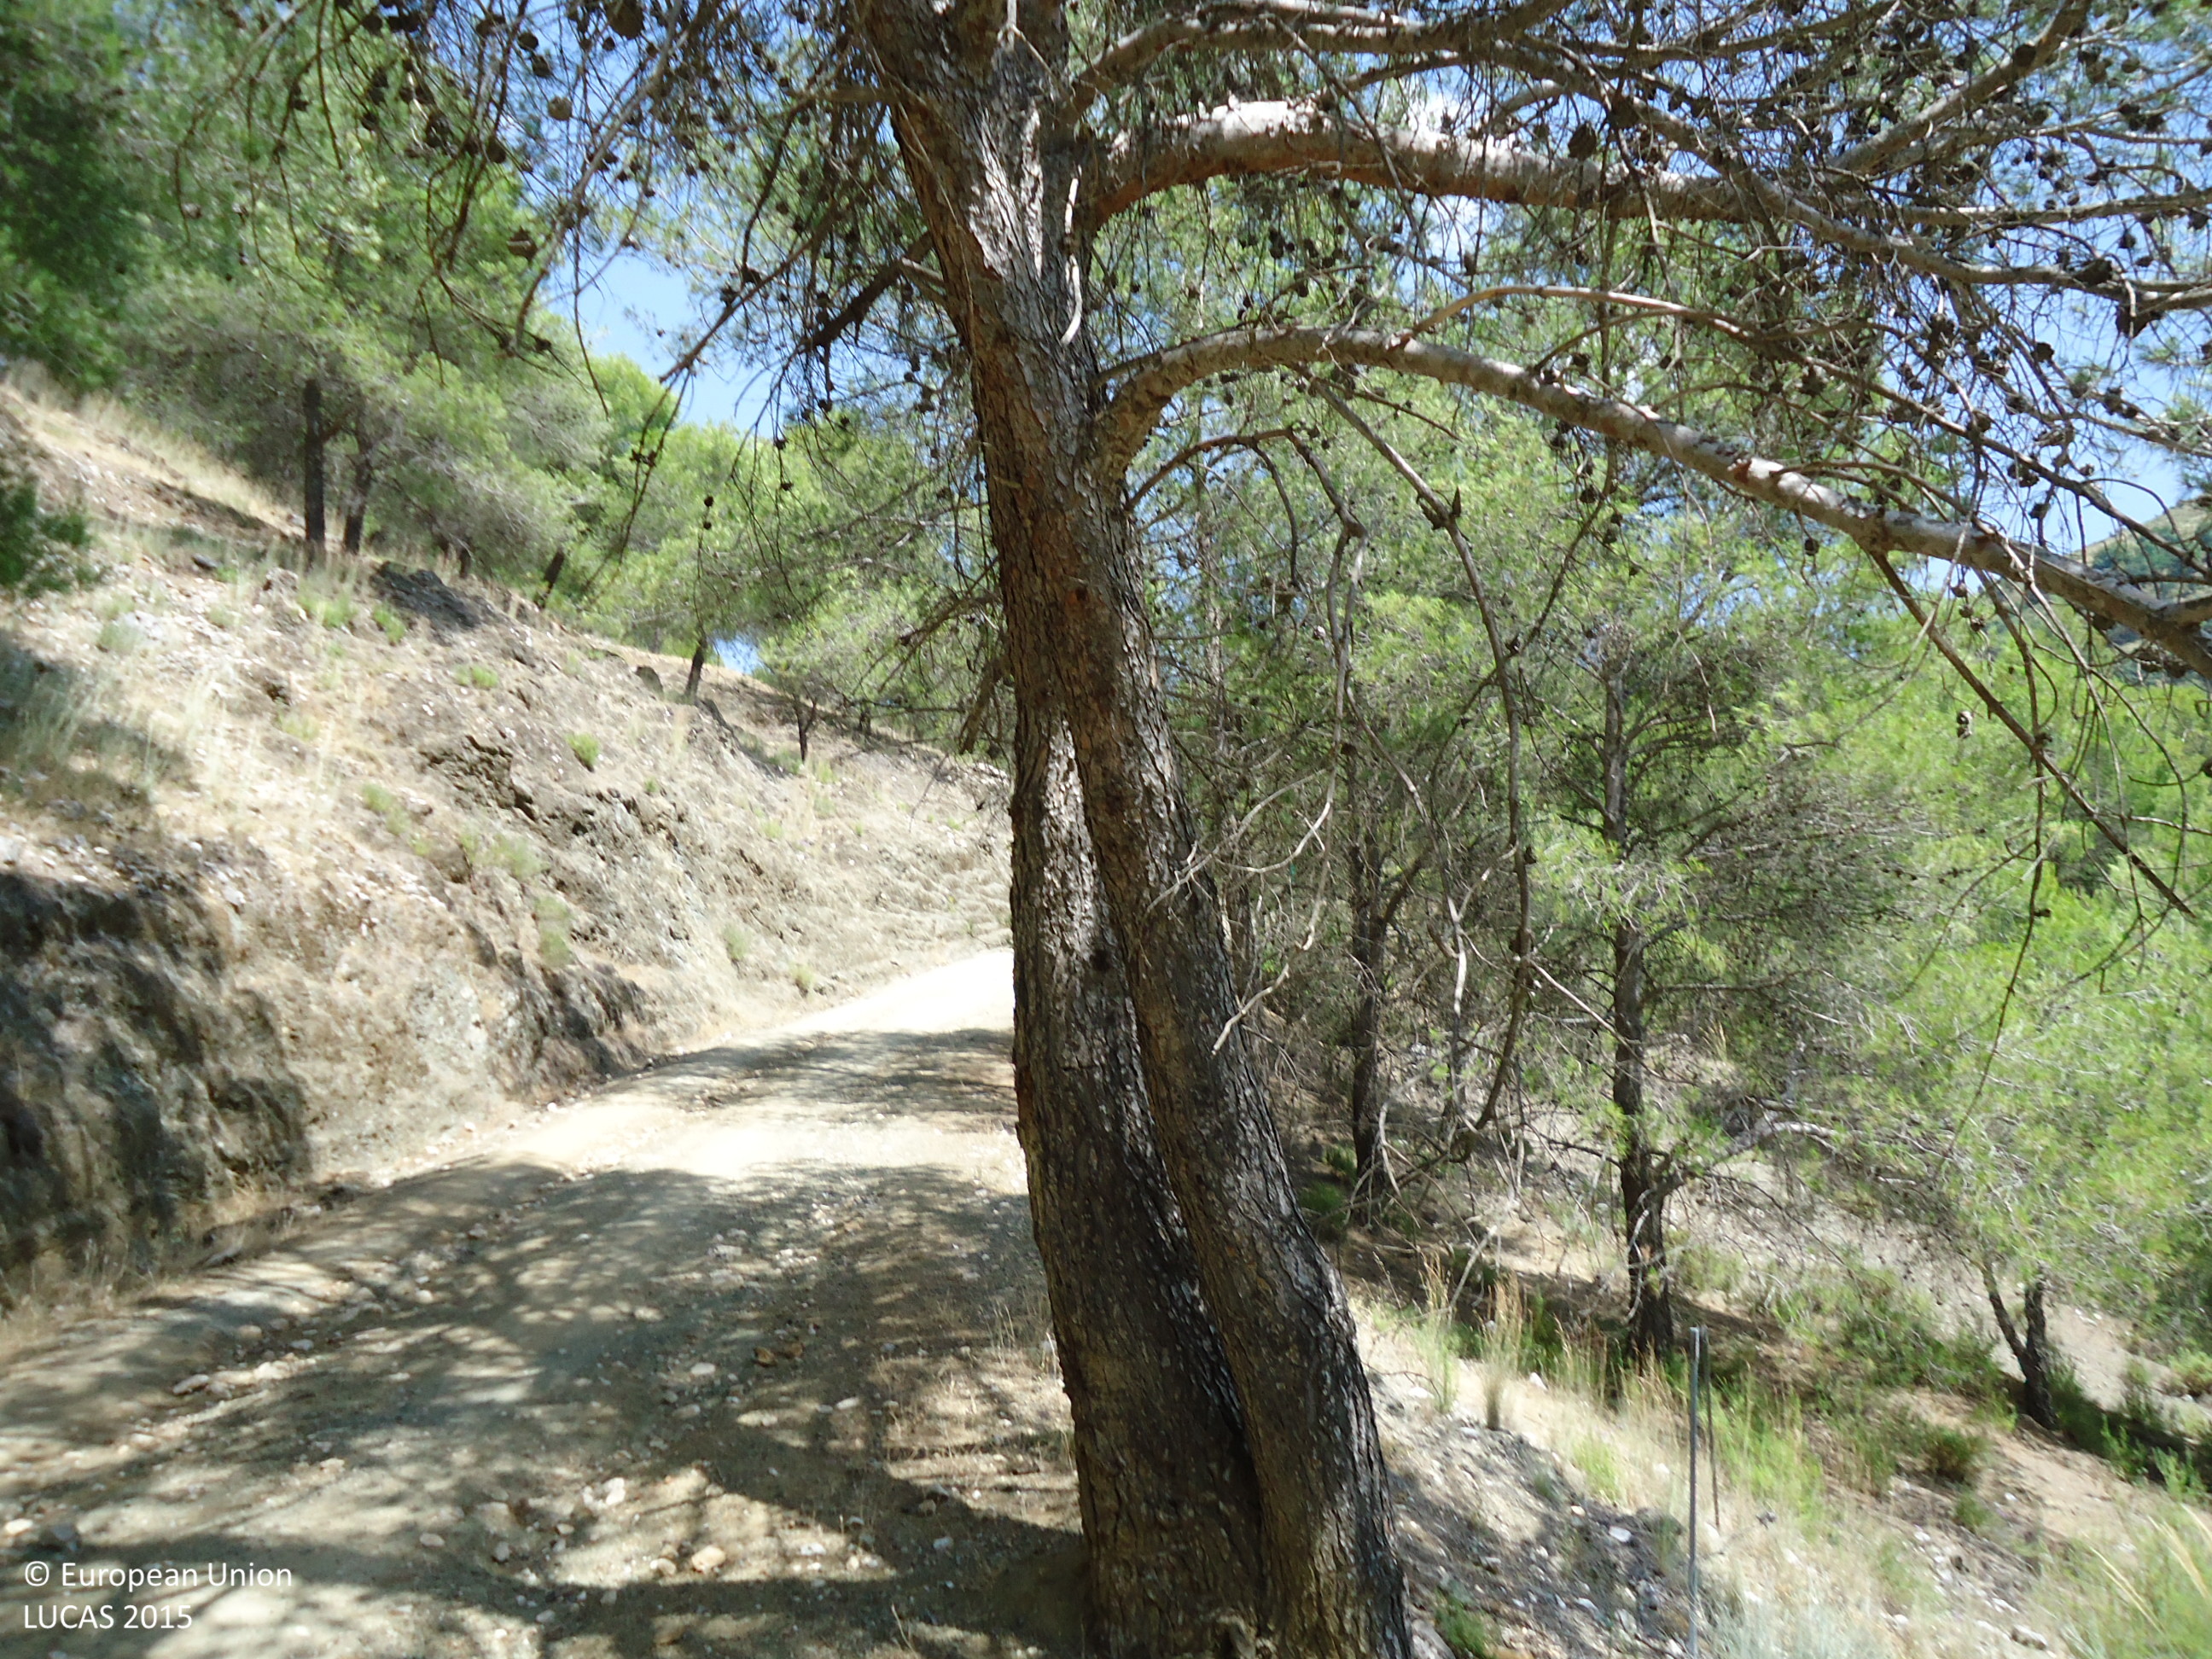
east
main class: Cropland
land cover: Olive groves
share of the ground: 10 - 25 %
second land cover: Spontaneously vegetated surfaces
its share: > 75 %
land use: Agriculture (excluding fallow land and kitchen gardens)
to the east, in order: Olive groves; Spontaneously vegetated surfaces; Fences; Pine dominated coniferous woodland; Tracks; Pine dominated coniferous woodland; Tracks; Pine dominated coniferous woodland
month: June
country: ES
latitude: 36.6896
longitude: -4.9362
